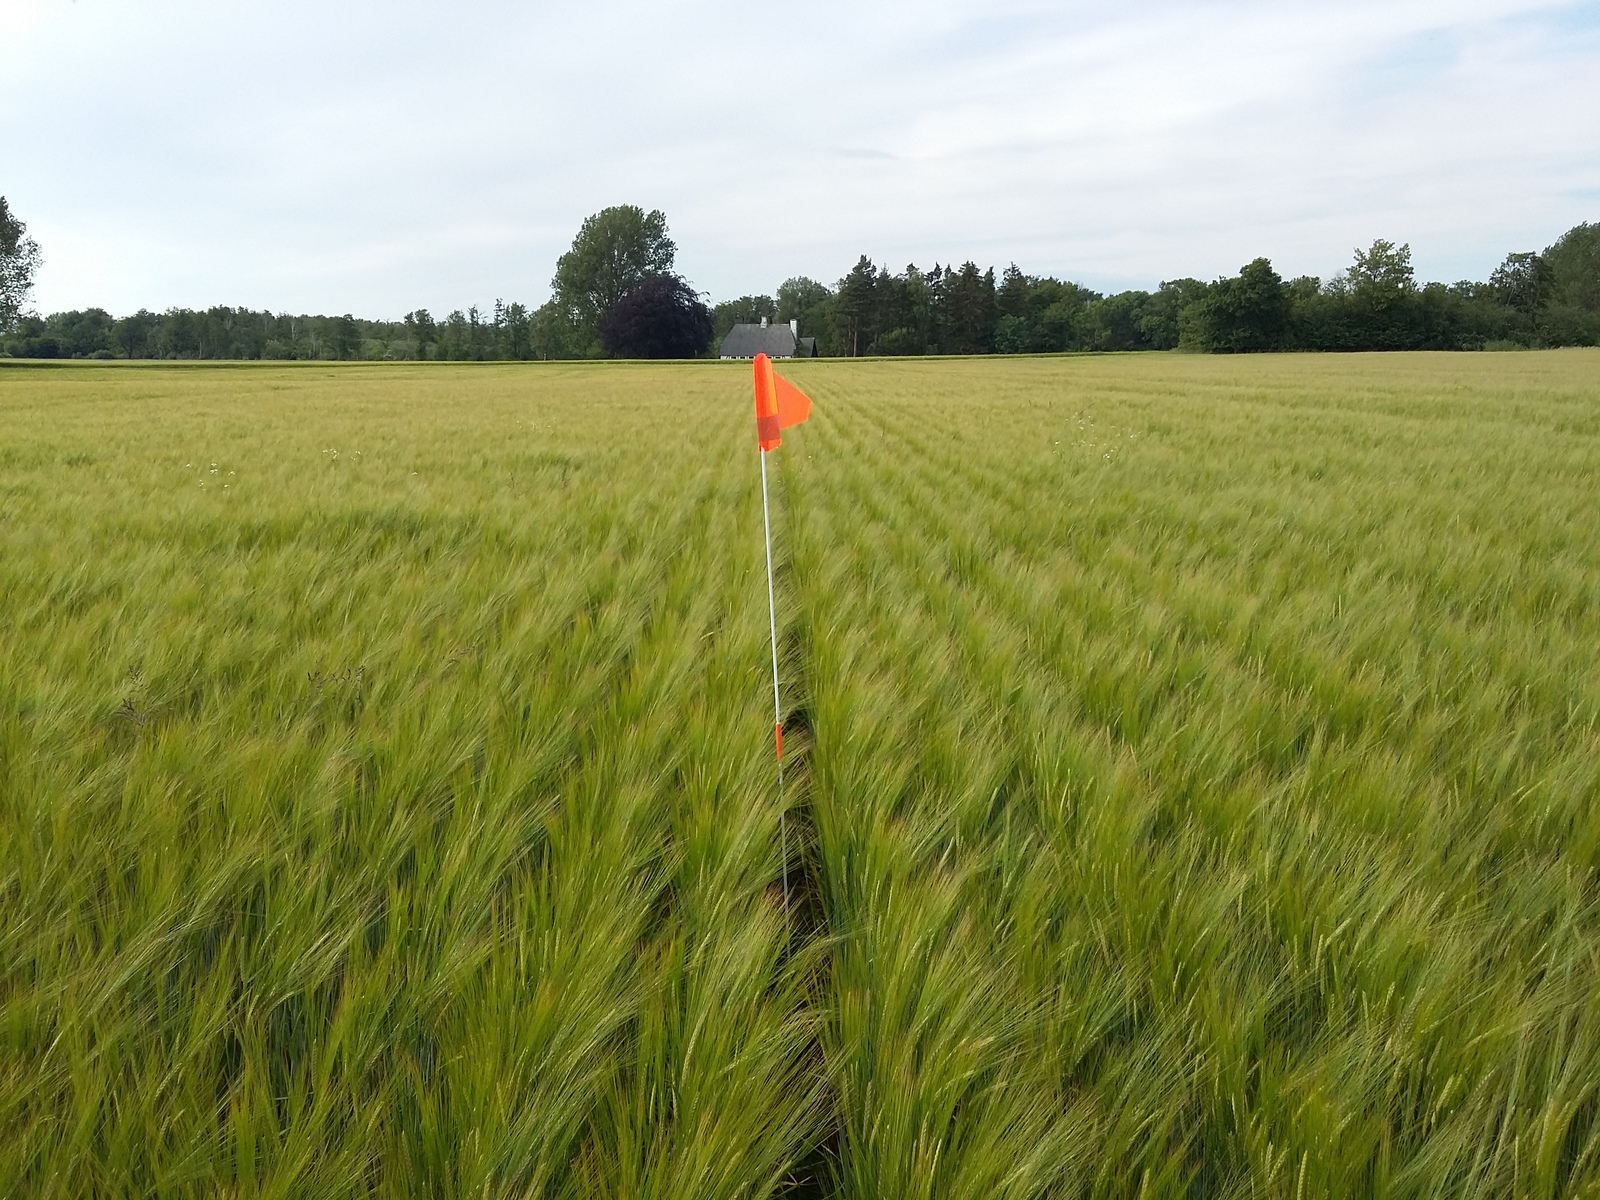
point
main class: Cropland
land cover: Barley
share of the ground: > 75 %
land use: Agriculture (excluding fallow land and kitchen gardens)
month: June
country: DK
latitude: 54.8056
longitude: 12.0057
